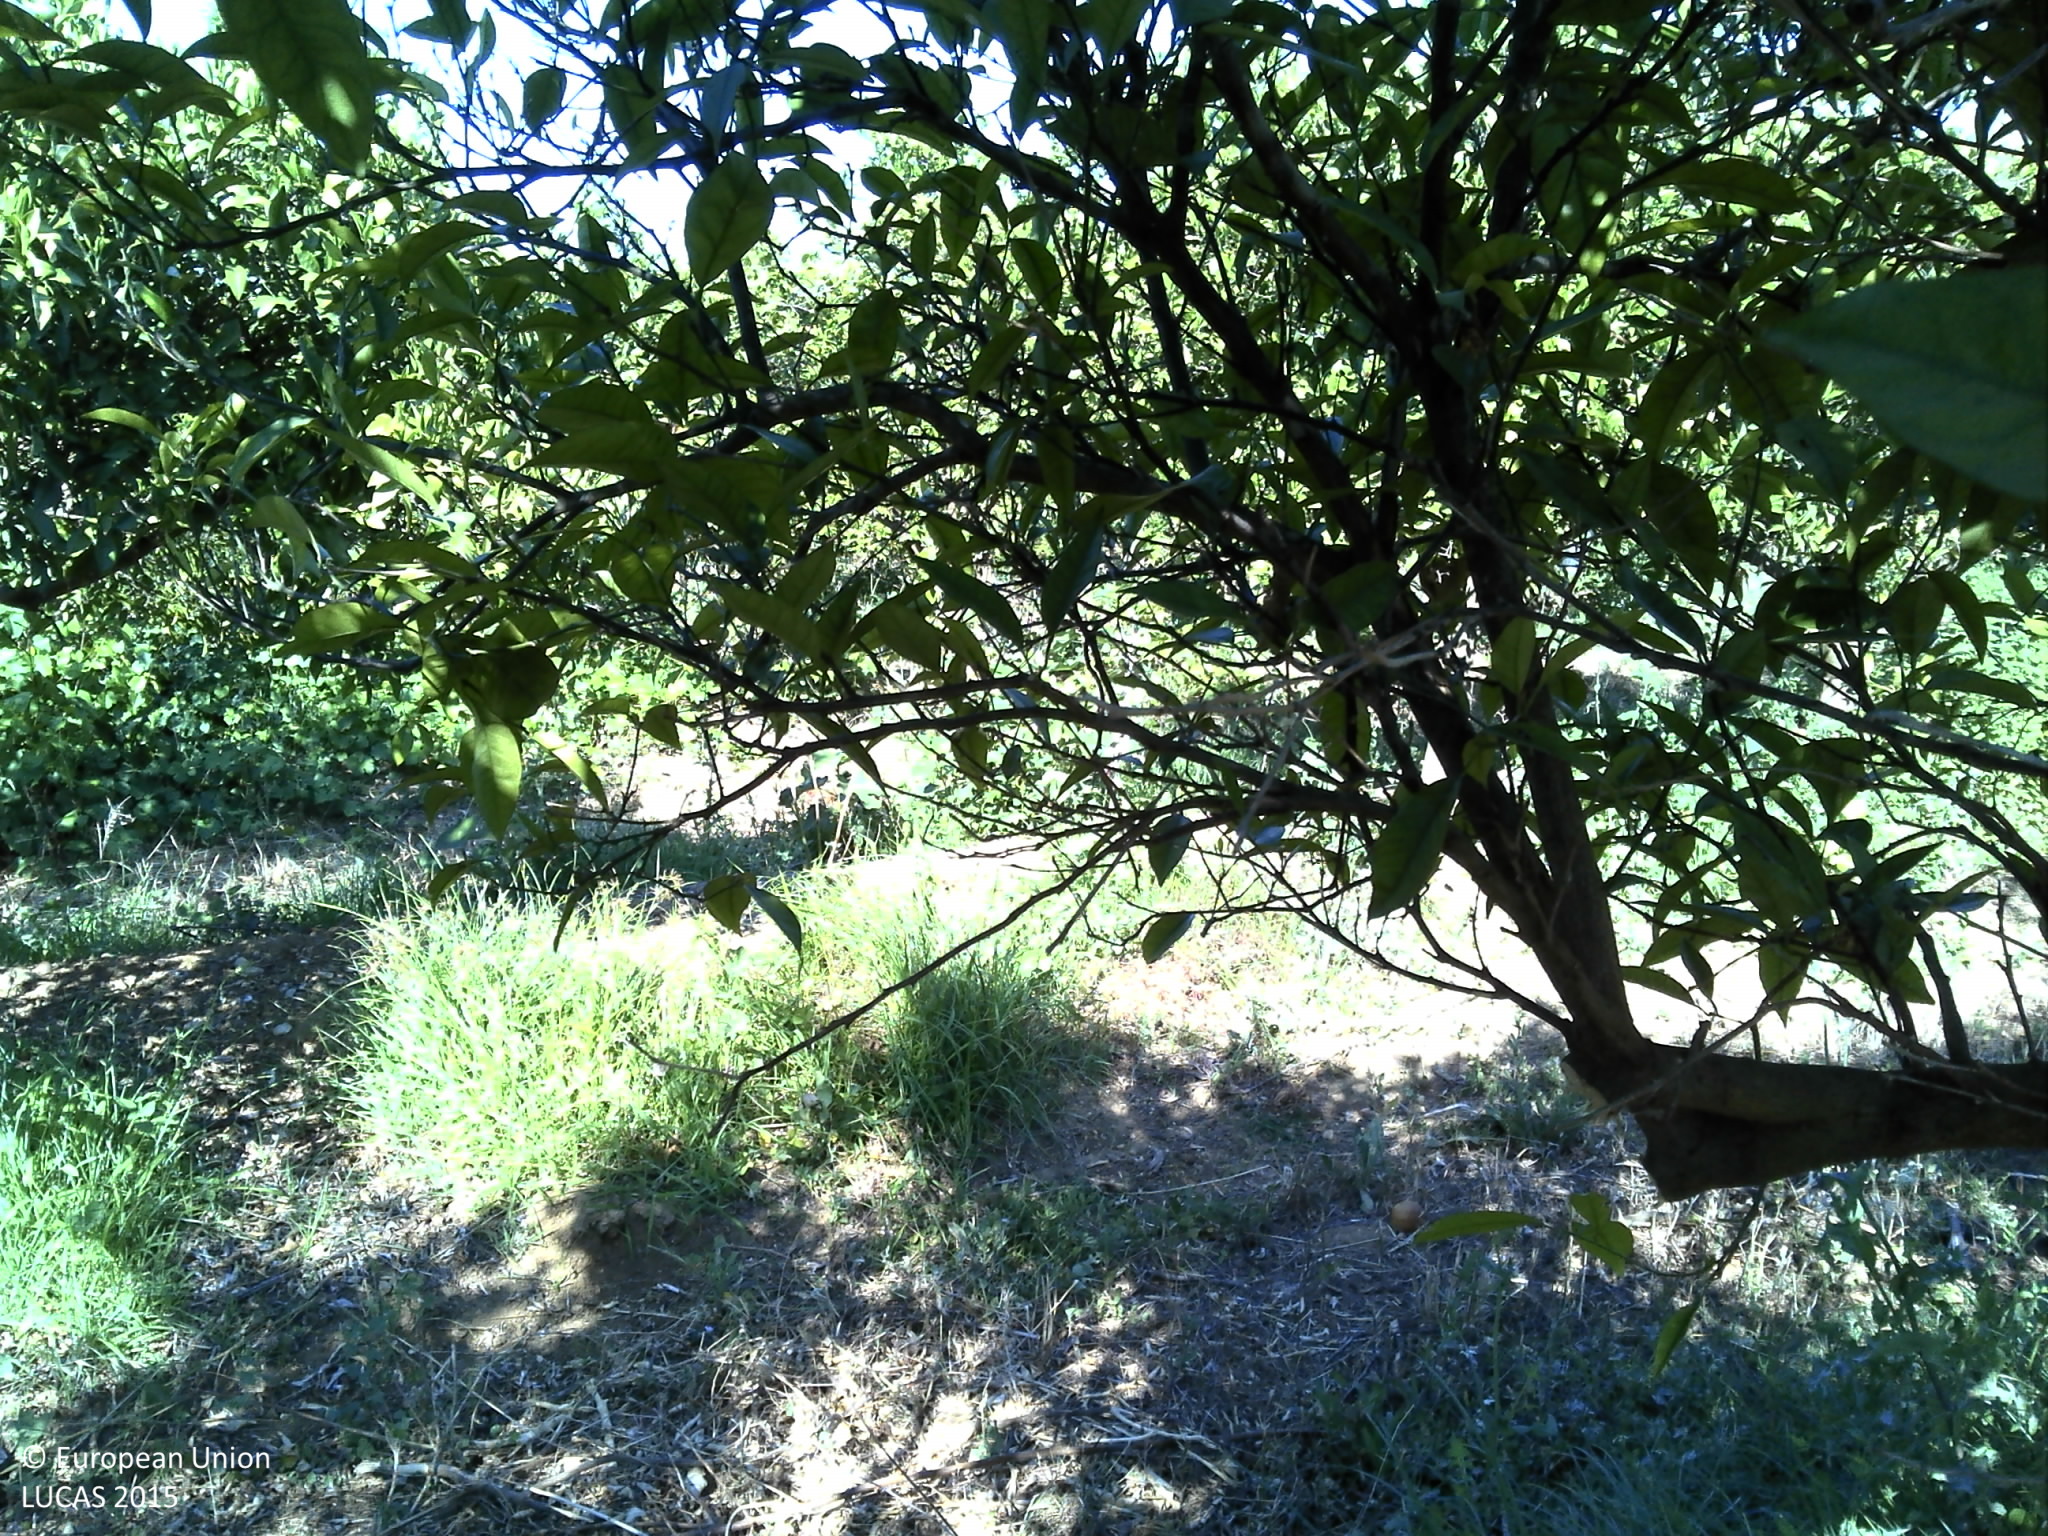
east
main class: Cropland
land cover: Oranges
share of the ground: > 75 %
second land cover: Spontaneously vegetated surfaces
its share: 10 - 25 %
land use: Agriculture (excluding fallow land and kitchen gardens)
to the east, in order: Oranges; Spontaneously vegetated surfaces; Fences; Other fruit trees and berries; Fences; Other citrus fruit; Fences; Oranges; Artificial constructions in urban areas; Oranges; Single bushes/trees; Electric lines; Grassland without tree/shrub cover; Fences; Electric lines; Single bushes/trees; Other fresh vegetables; Vineyards; Single bushes/trees; Dry stone walls; Paved roads, cycling and walking lanes; Artificial constructions; Single bushes/trees; Dry stone walls; Grassland without tree/shrub cover; Fences; Oranges
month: June
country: PT
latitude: 37.1162
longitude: -7.6626
